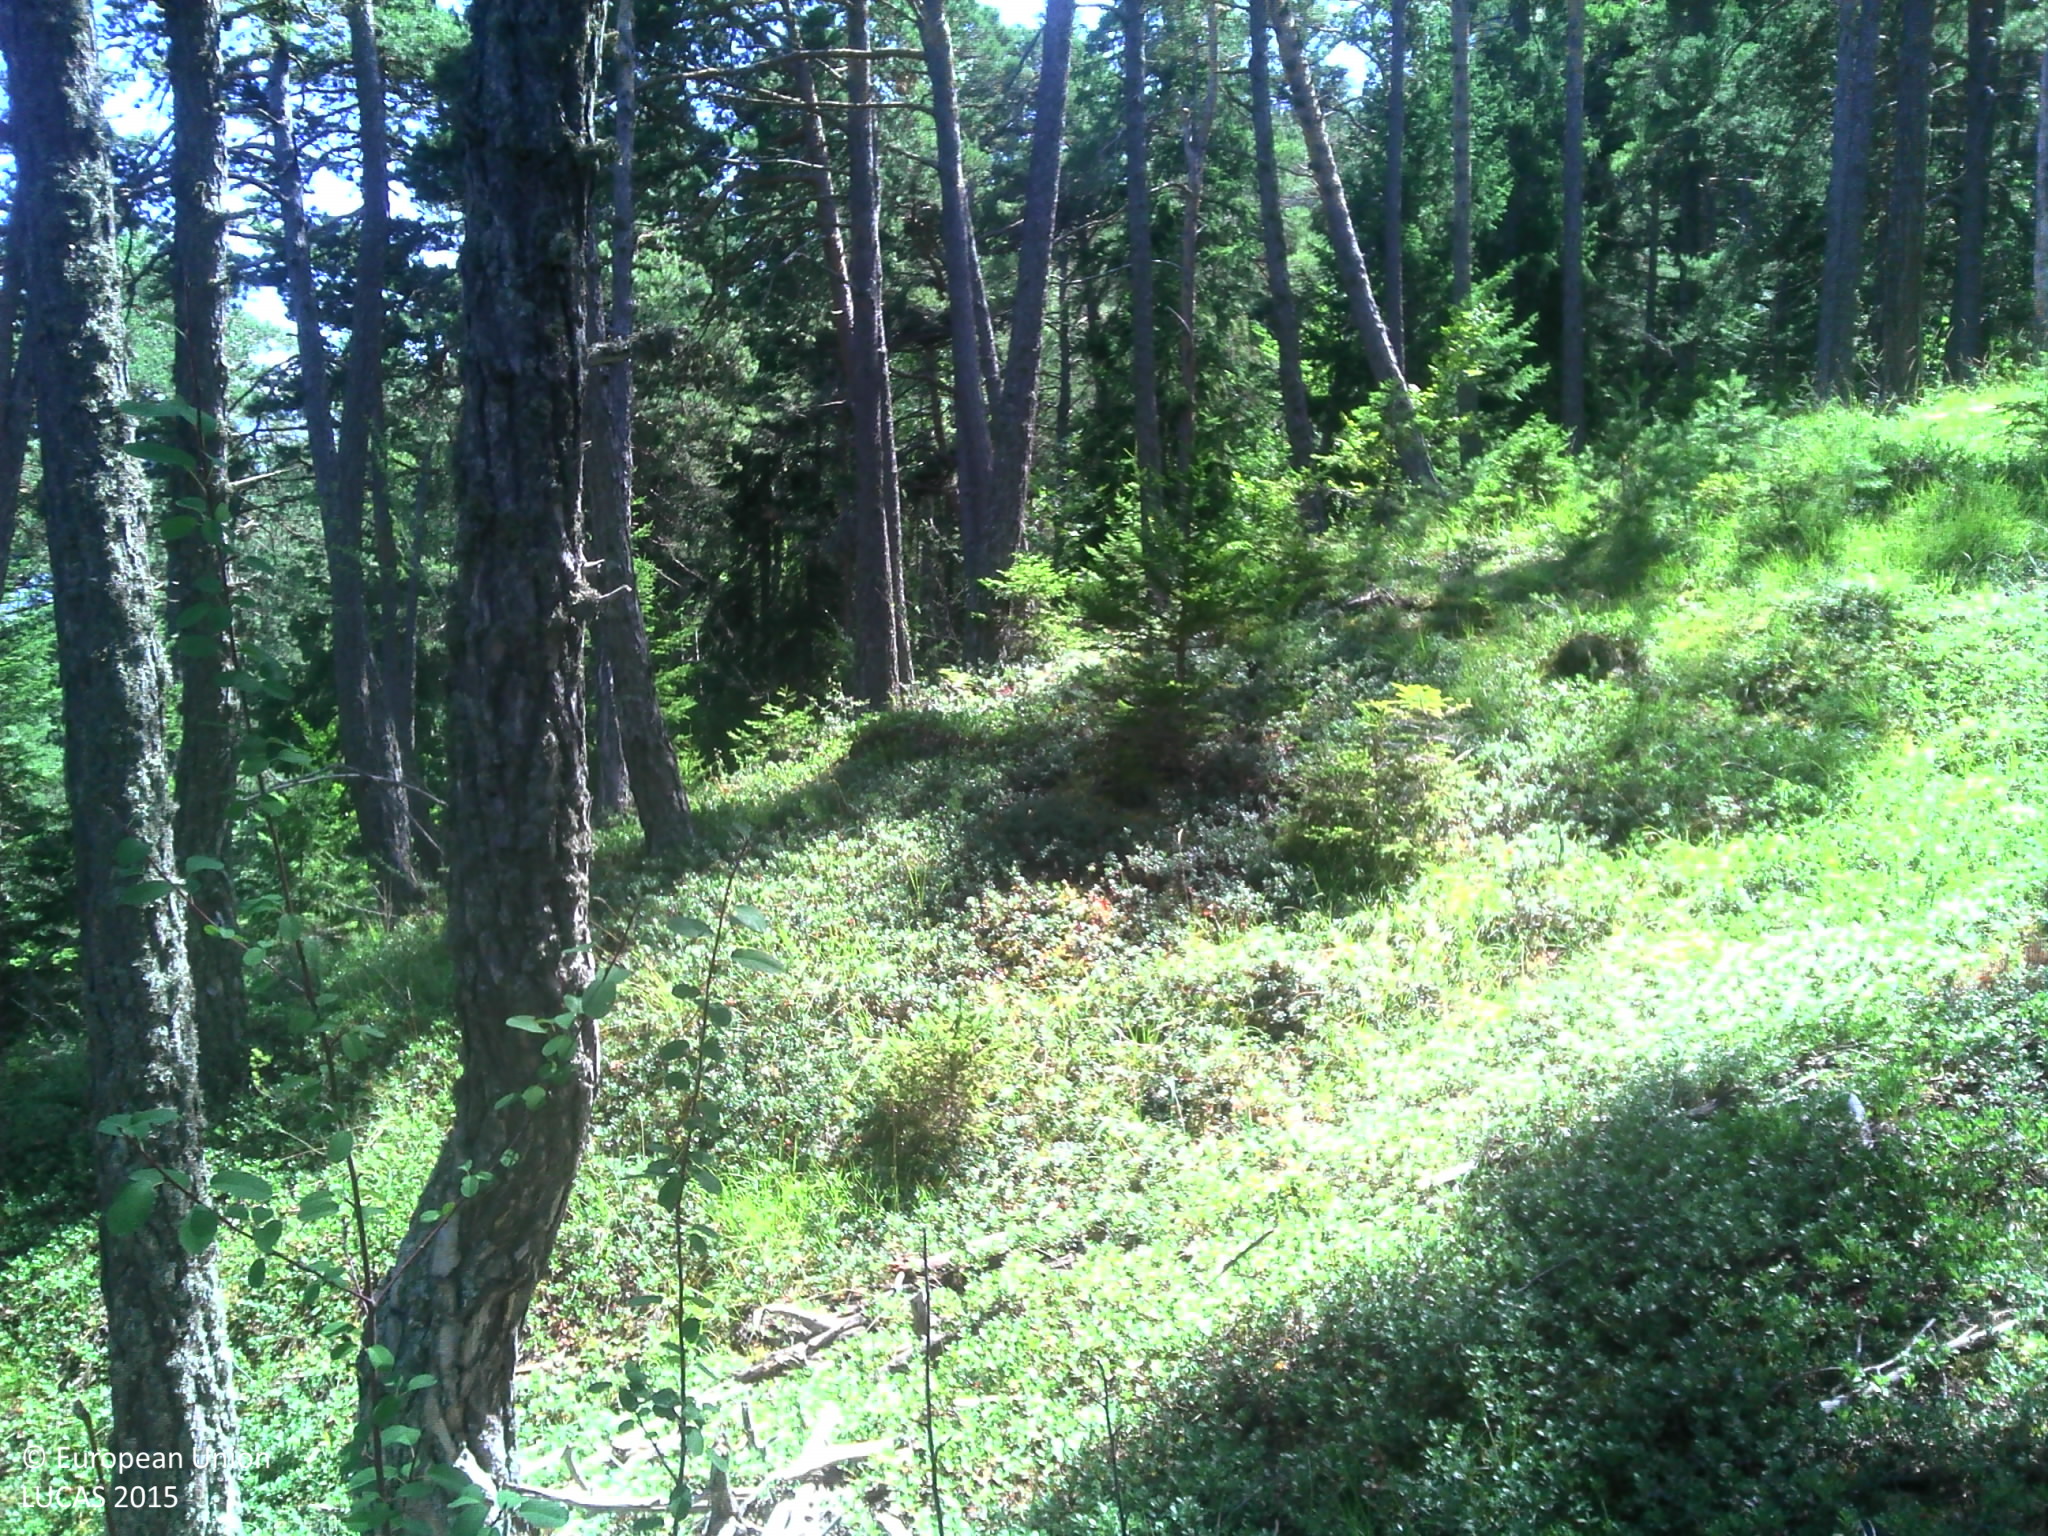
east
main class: Woodland
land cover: Pine dominated coniferous woodland
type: alpine coniferous forest
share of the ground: 50 - 75 %
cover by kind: coniferous forest trees 65 %, lichens and mosses 15 %, shrubs 10 %, herbaceous plants 10 %
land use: Forestry
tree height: > 5 m
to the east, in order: Pine dominated coniferous woodland; Fences; Pine dominated coniferous woodland; Ditches and canals; Pine dominated coniferous woodland; Tracks; Pine dominated coniferous woodland
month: August
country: FR
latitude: 44.3570
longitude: 6.3057
